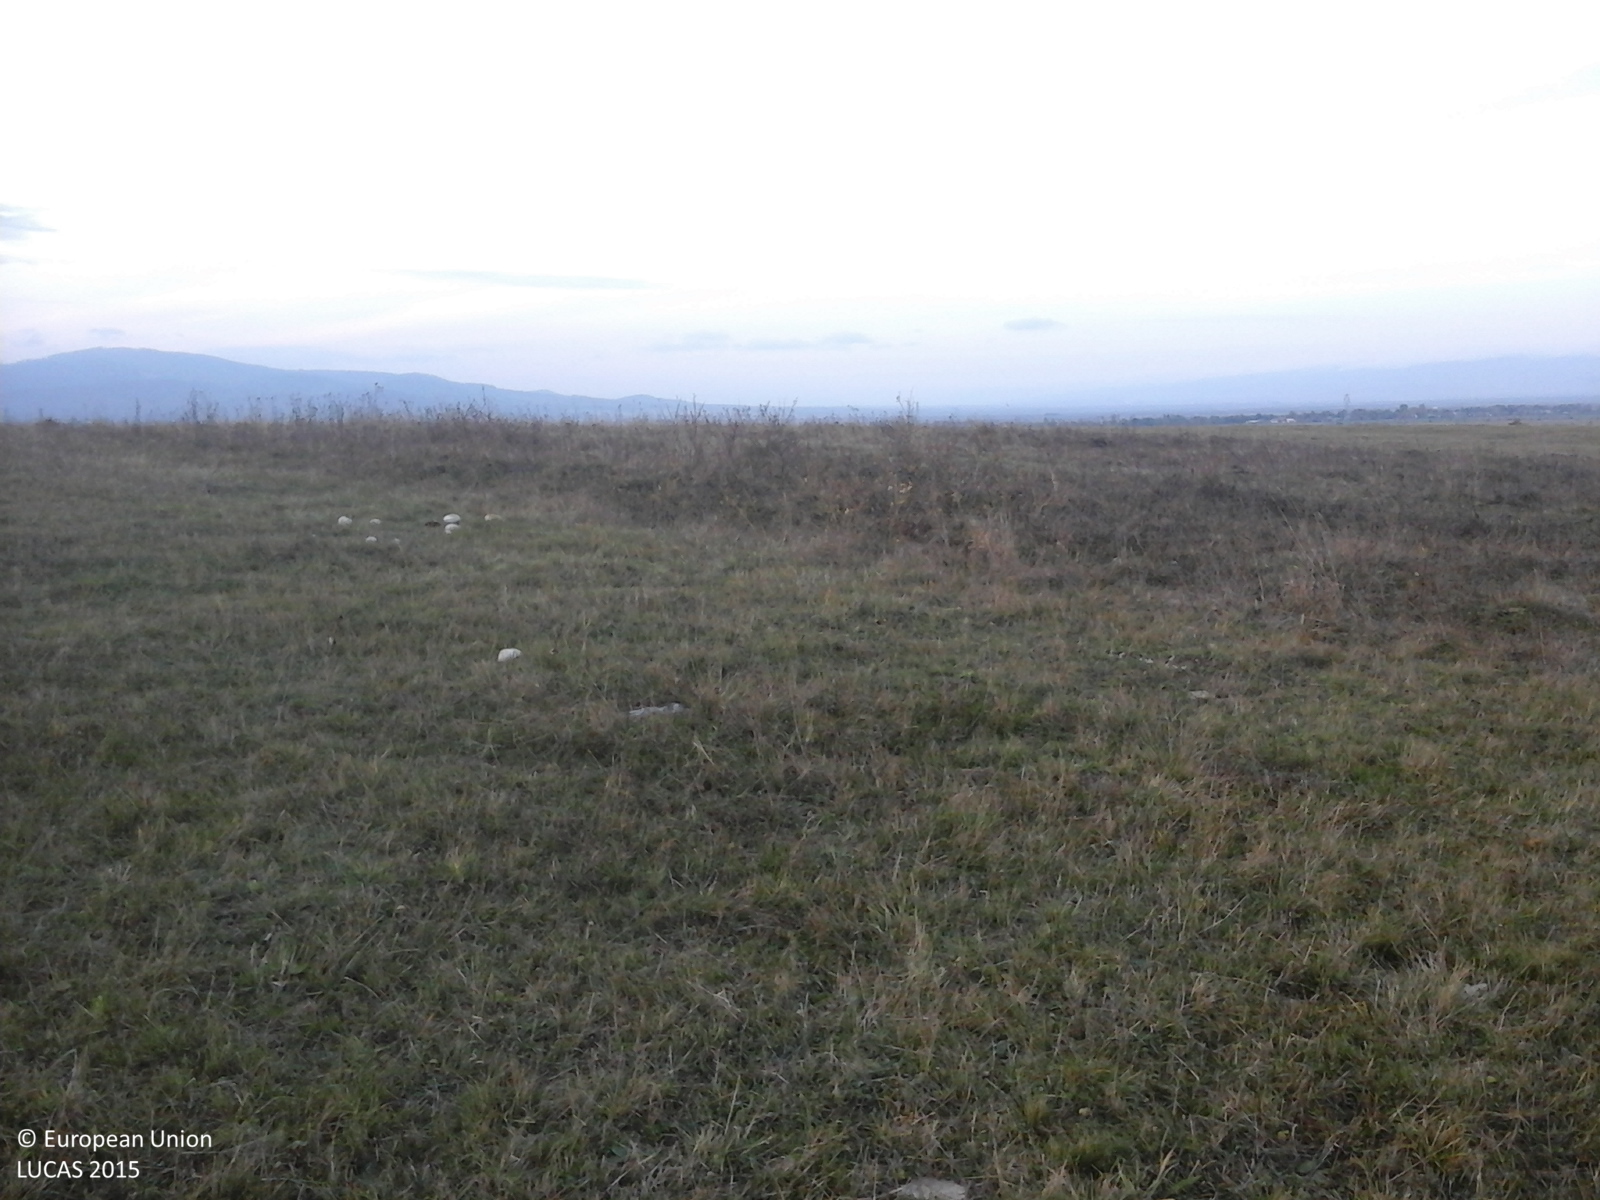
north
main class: Grassland
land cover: Grassland without tree/shrub cover
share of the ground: > 75 %
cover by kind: herbaceous plants 100 %
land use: Agriculture (excluding fallow land and kitchen gardens)
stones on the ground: < 10 %
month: October
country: RO
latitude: 46.6691
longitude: 25.4407
